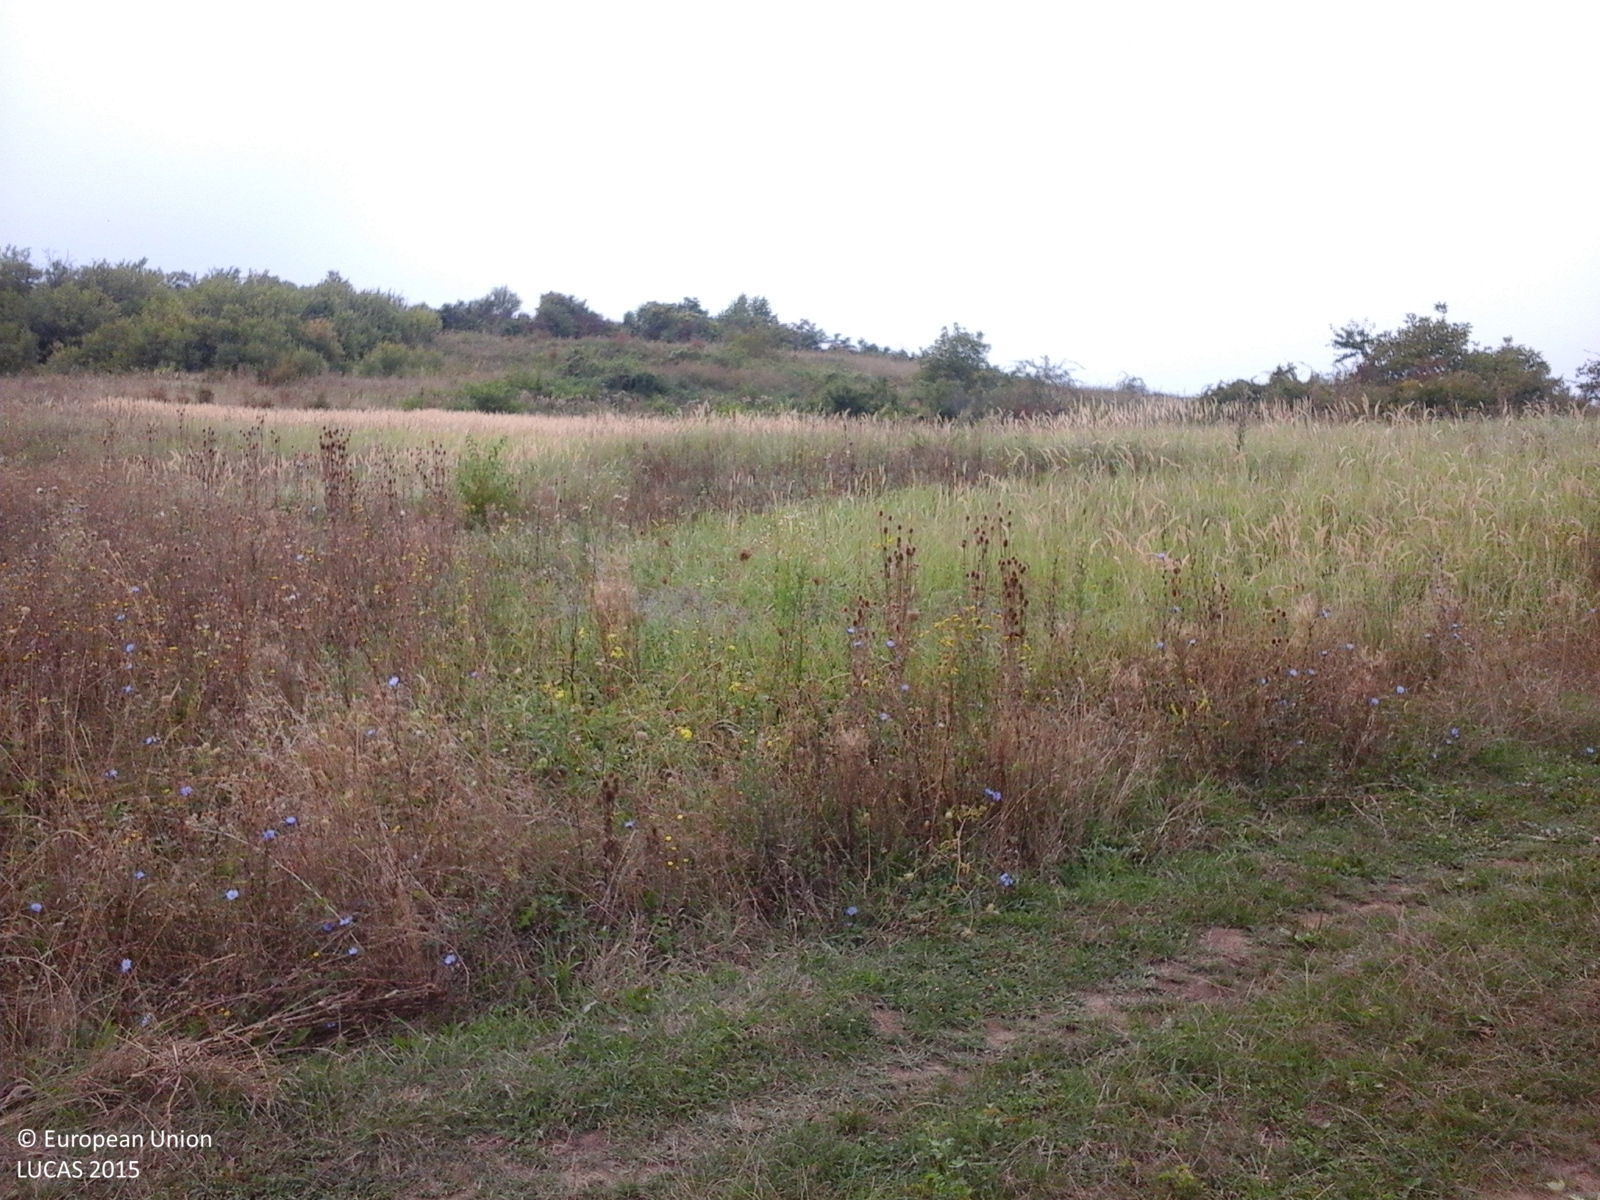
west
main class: Grassland
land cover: Spontaneously vegetated surfaces
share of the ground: > 75 %
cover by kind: herbaceous plants 100 %
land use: Fallow land
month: September
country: RO
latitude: 47.1756
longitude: 23.0070
